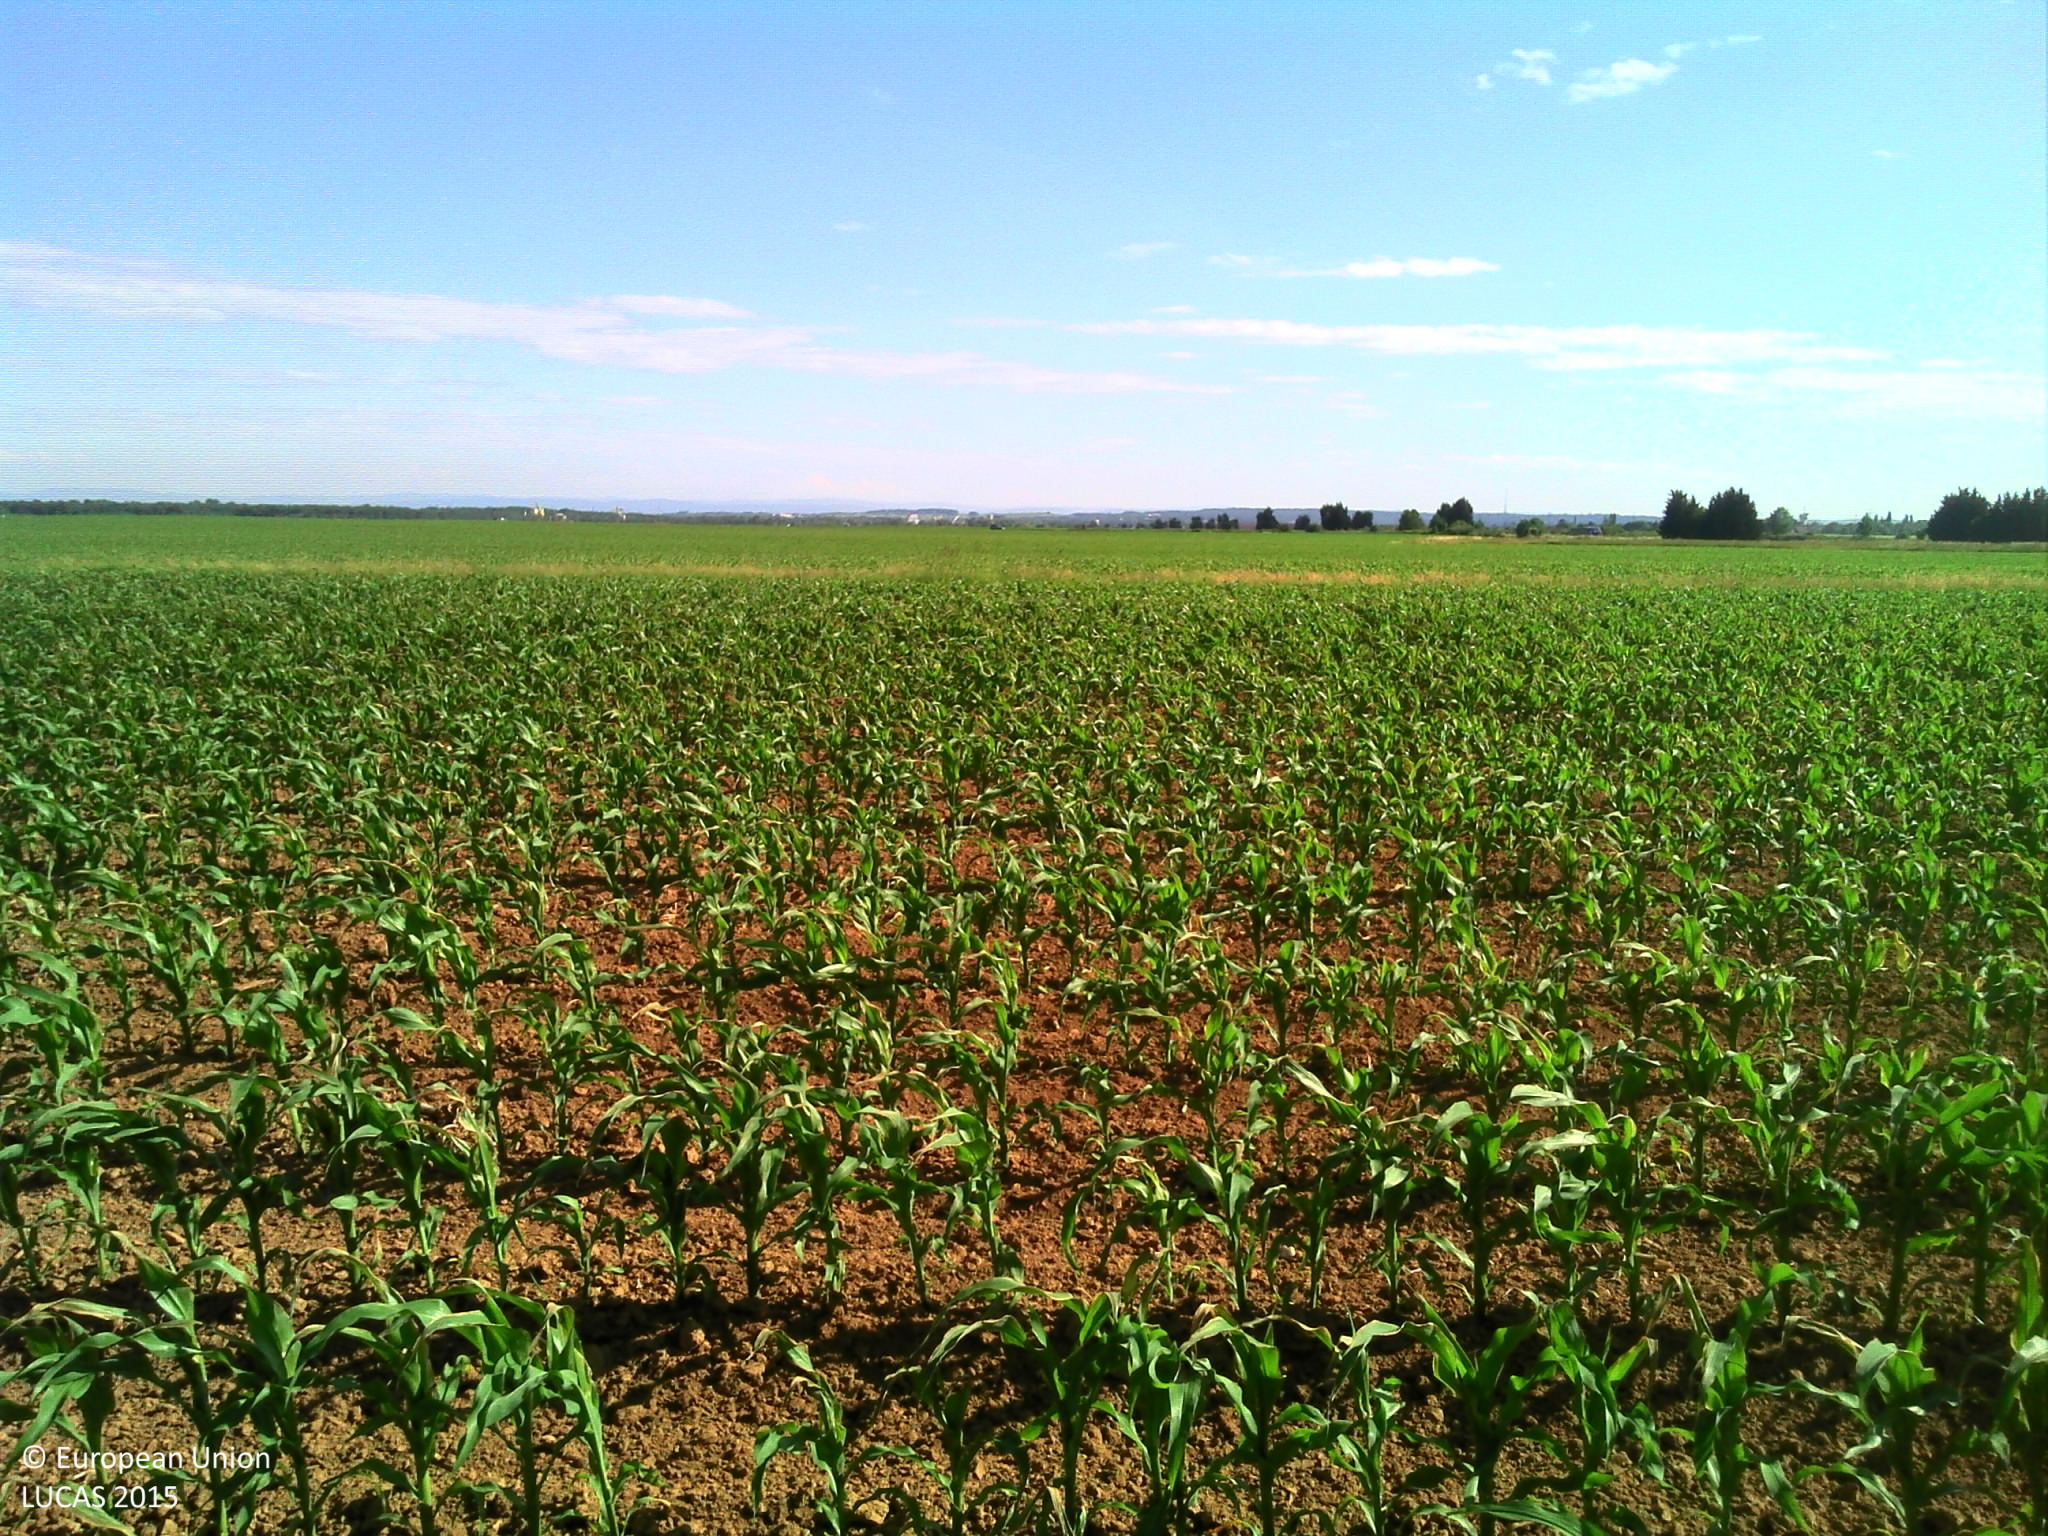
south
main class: Cropland
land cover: Maize
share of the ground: 50 - 75 %
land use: Agriculture (excluding fallow land and kitchen gardens)
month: June
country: FR
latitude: 47.8327
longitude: 7.3963
